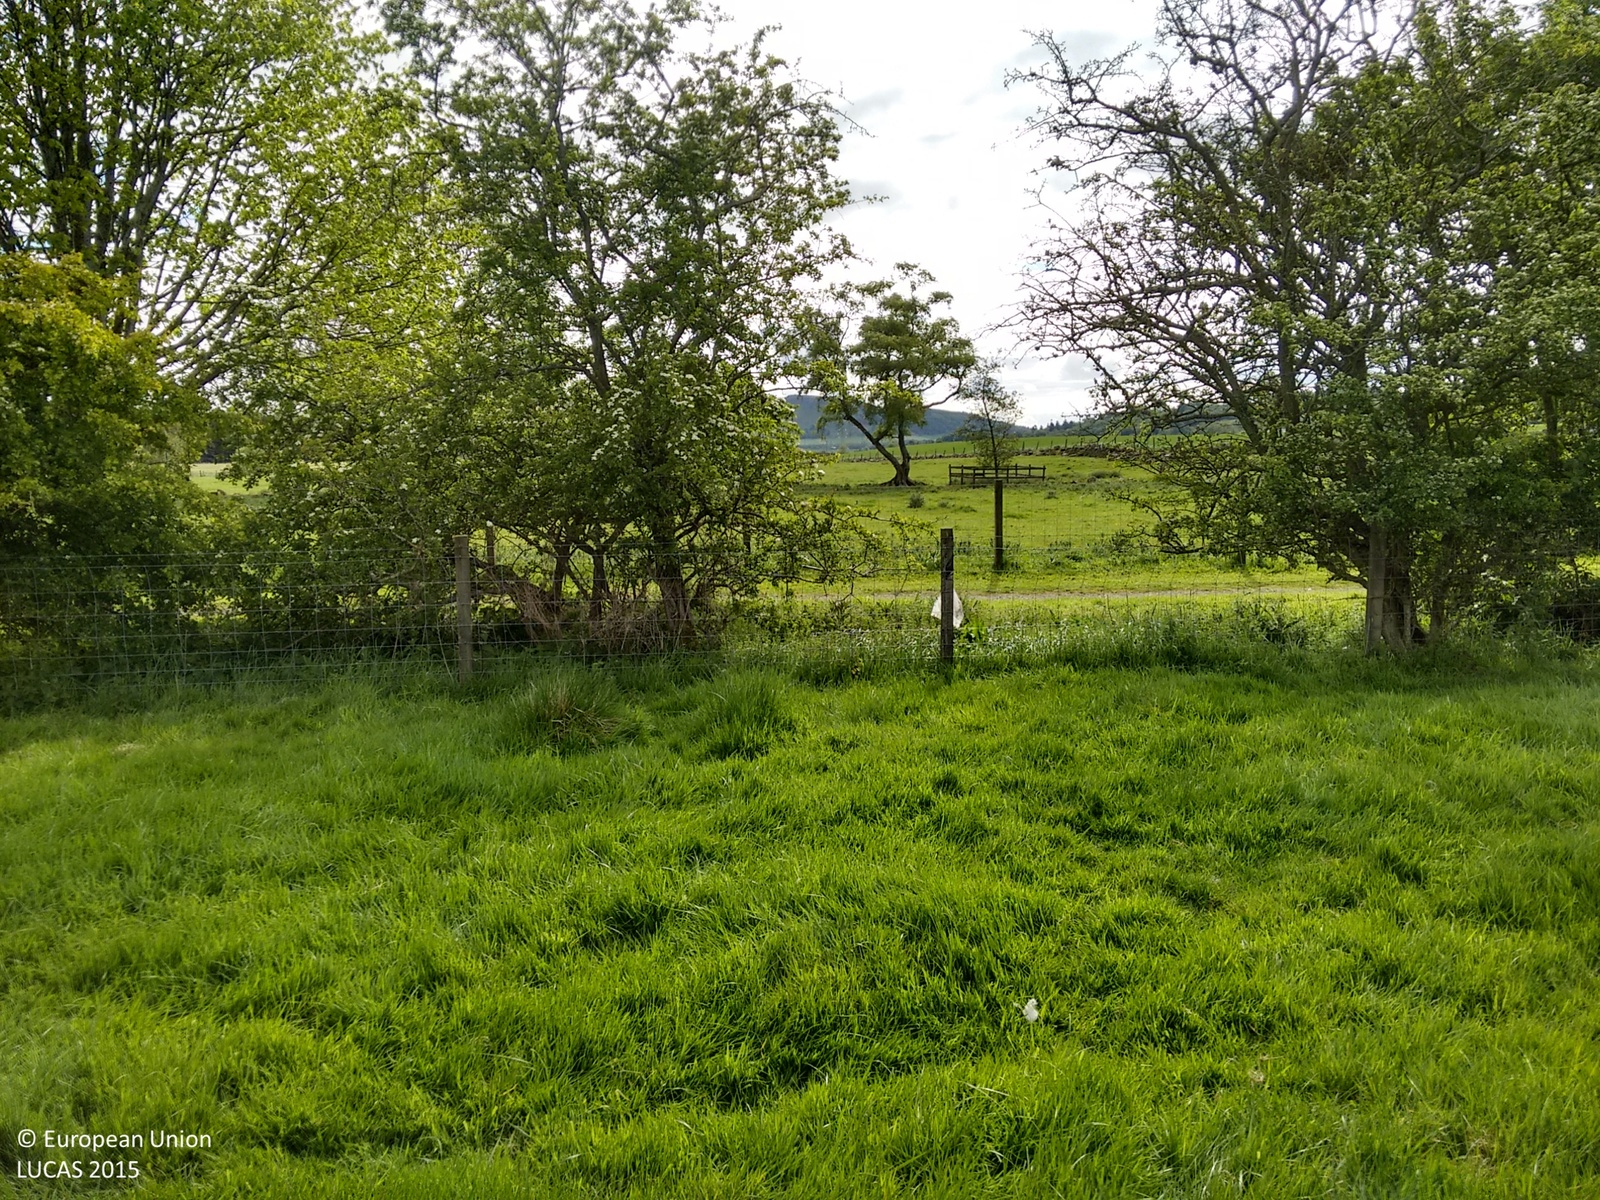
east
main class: Grassland
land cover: Grassland without tree/shrub cover
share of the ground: > 75 %
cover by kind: herbaceous plants 100 %
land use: Agriculture (excluding fallow land and kitchen gardens)
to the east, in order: Grassland without tree/shrub cover; Fences; Abandoned hedges; Tracks; Fences; Grassland without tree/shrub cover; Electric lines; Lines of trees; Grassland without tree/shrub cover; Fences; Grassland without tree/shrub cover; Rivers and streams
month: June
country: GB
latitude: 56.1682
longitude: -3.4588
